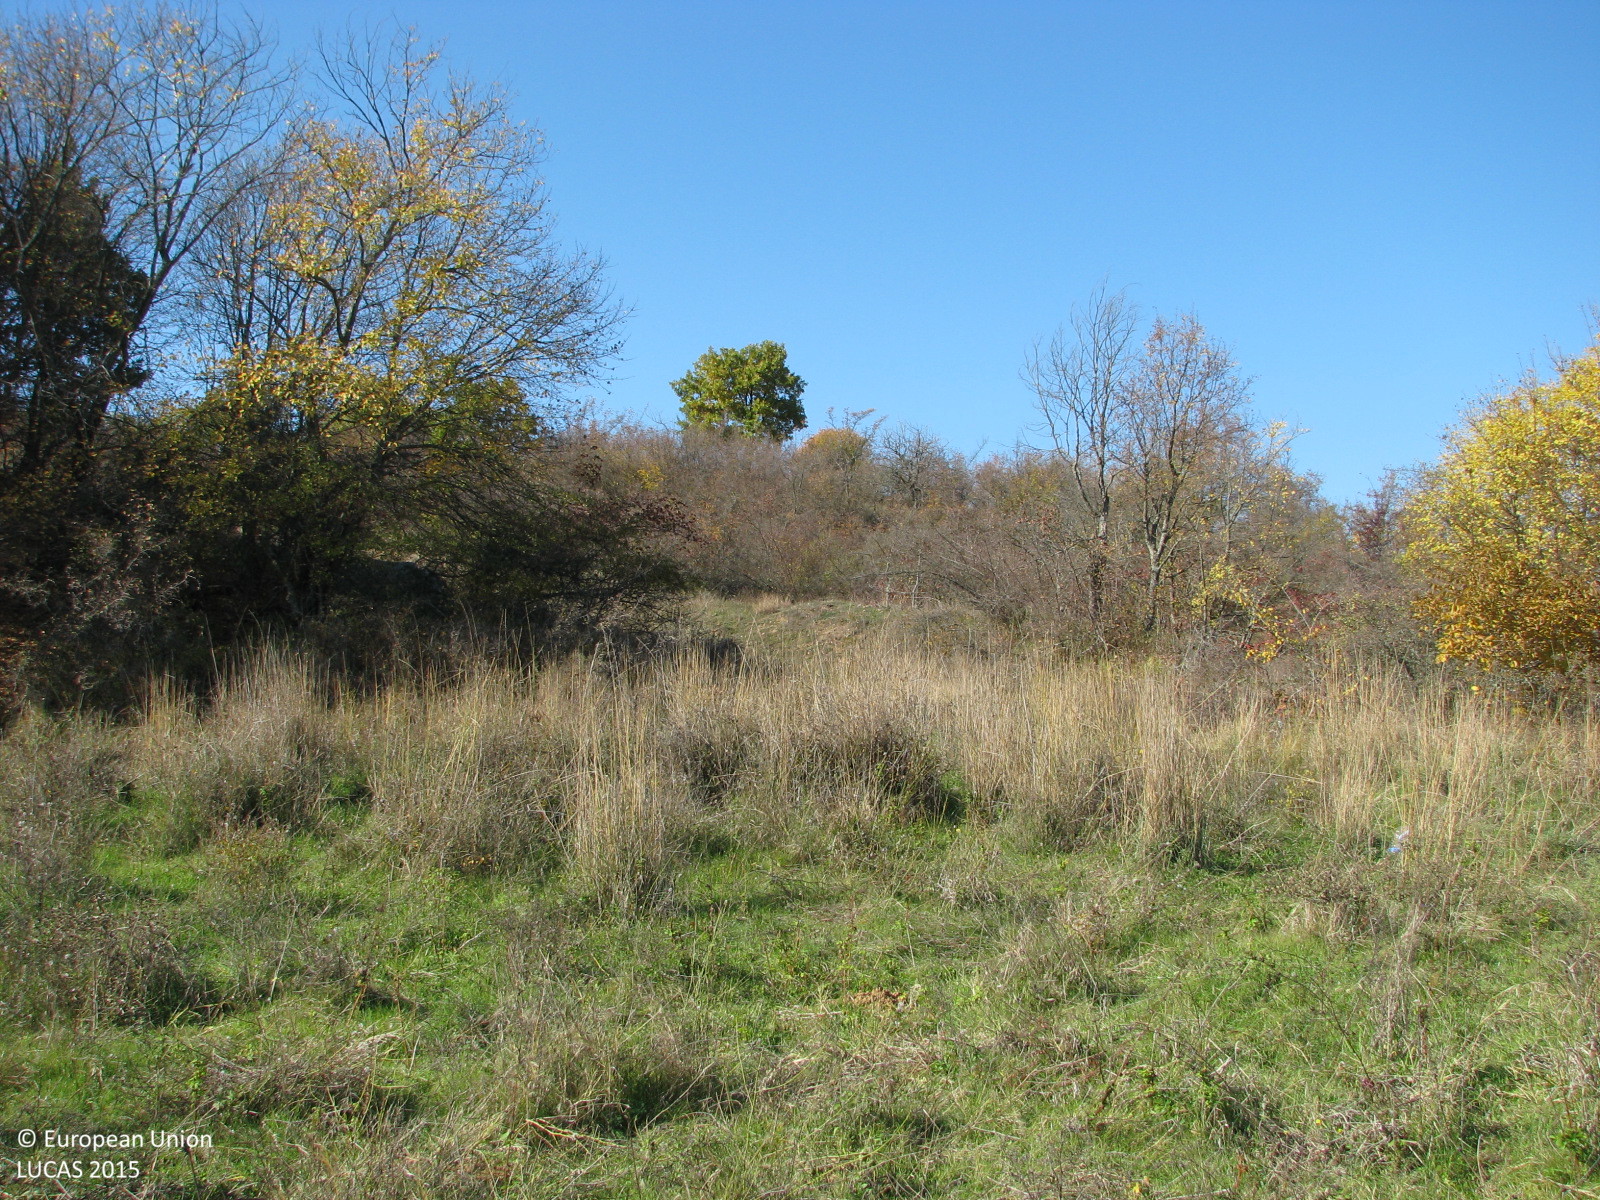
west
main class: Grassland
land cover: Grassland with sparse tree/shrub cover
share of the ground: > 75 %
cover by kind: herbaceous plants 90 %, broadleaved forest trees 5 %, shrubs 5 %
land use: Agriculture (excluding fallow land and kitchen gardens)
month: November
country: BG
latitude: 41.8968
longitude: 26.3899
